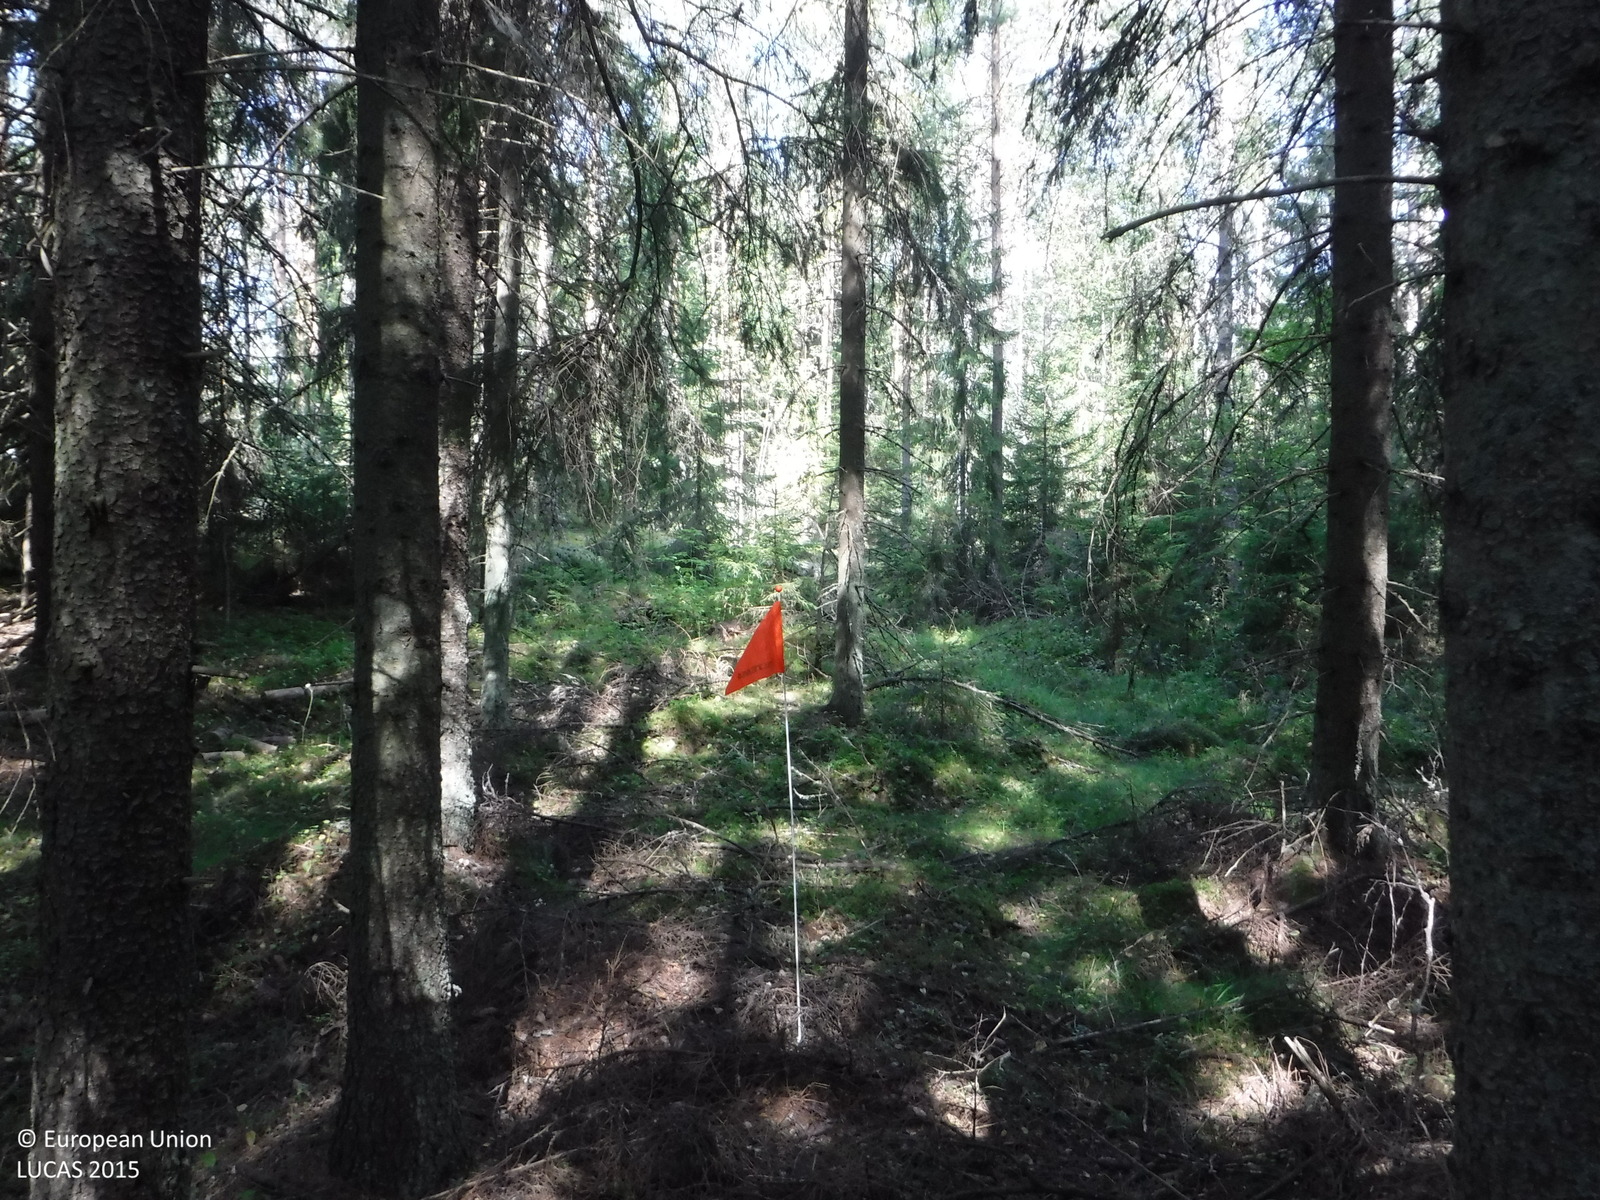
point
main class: Woodland
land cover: Spruce dominated coniferous woodland
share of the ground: > 75 %
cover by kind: coniferous forest trees 80 %, unconsolidated bare surface 15 %, herbaceous plants 5 %
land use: Forestry
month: August
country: FI
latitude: 61.0878
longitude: 22.0192
